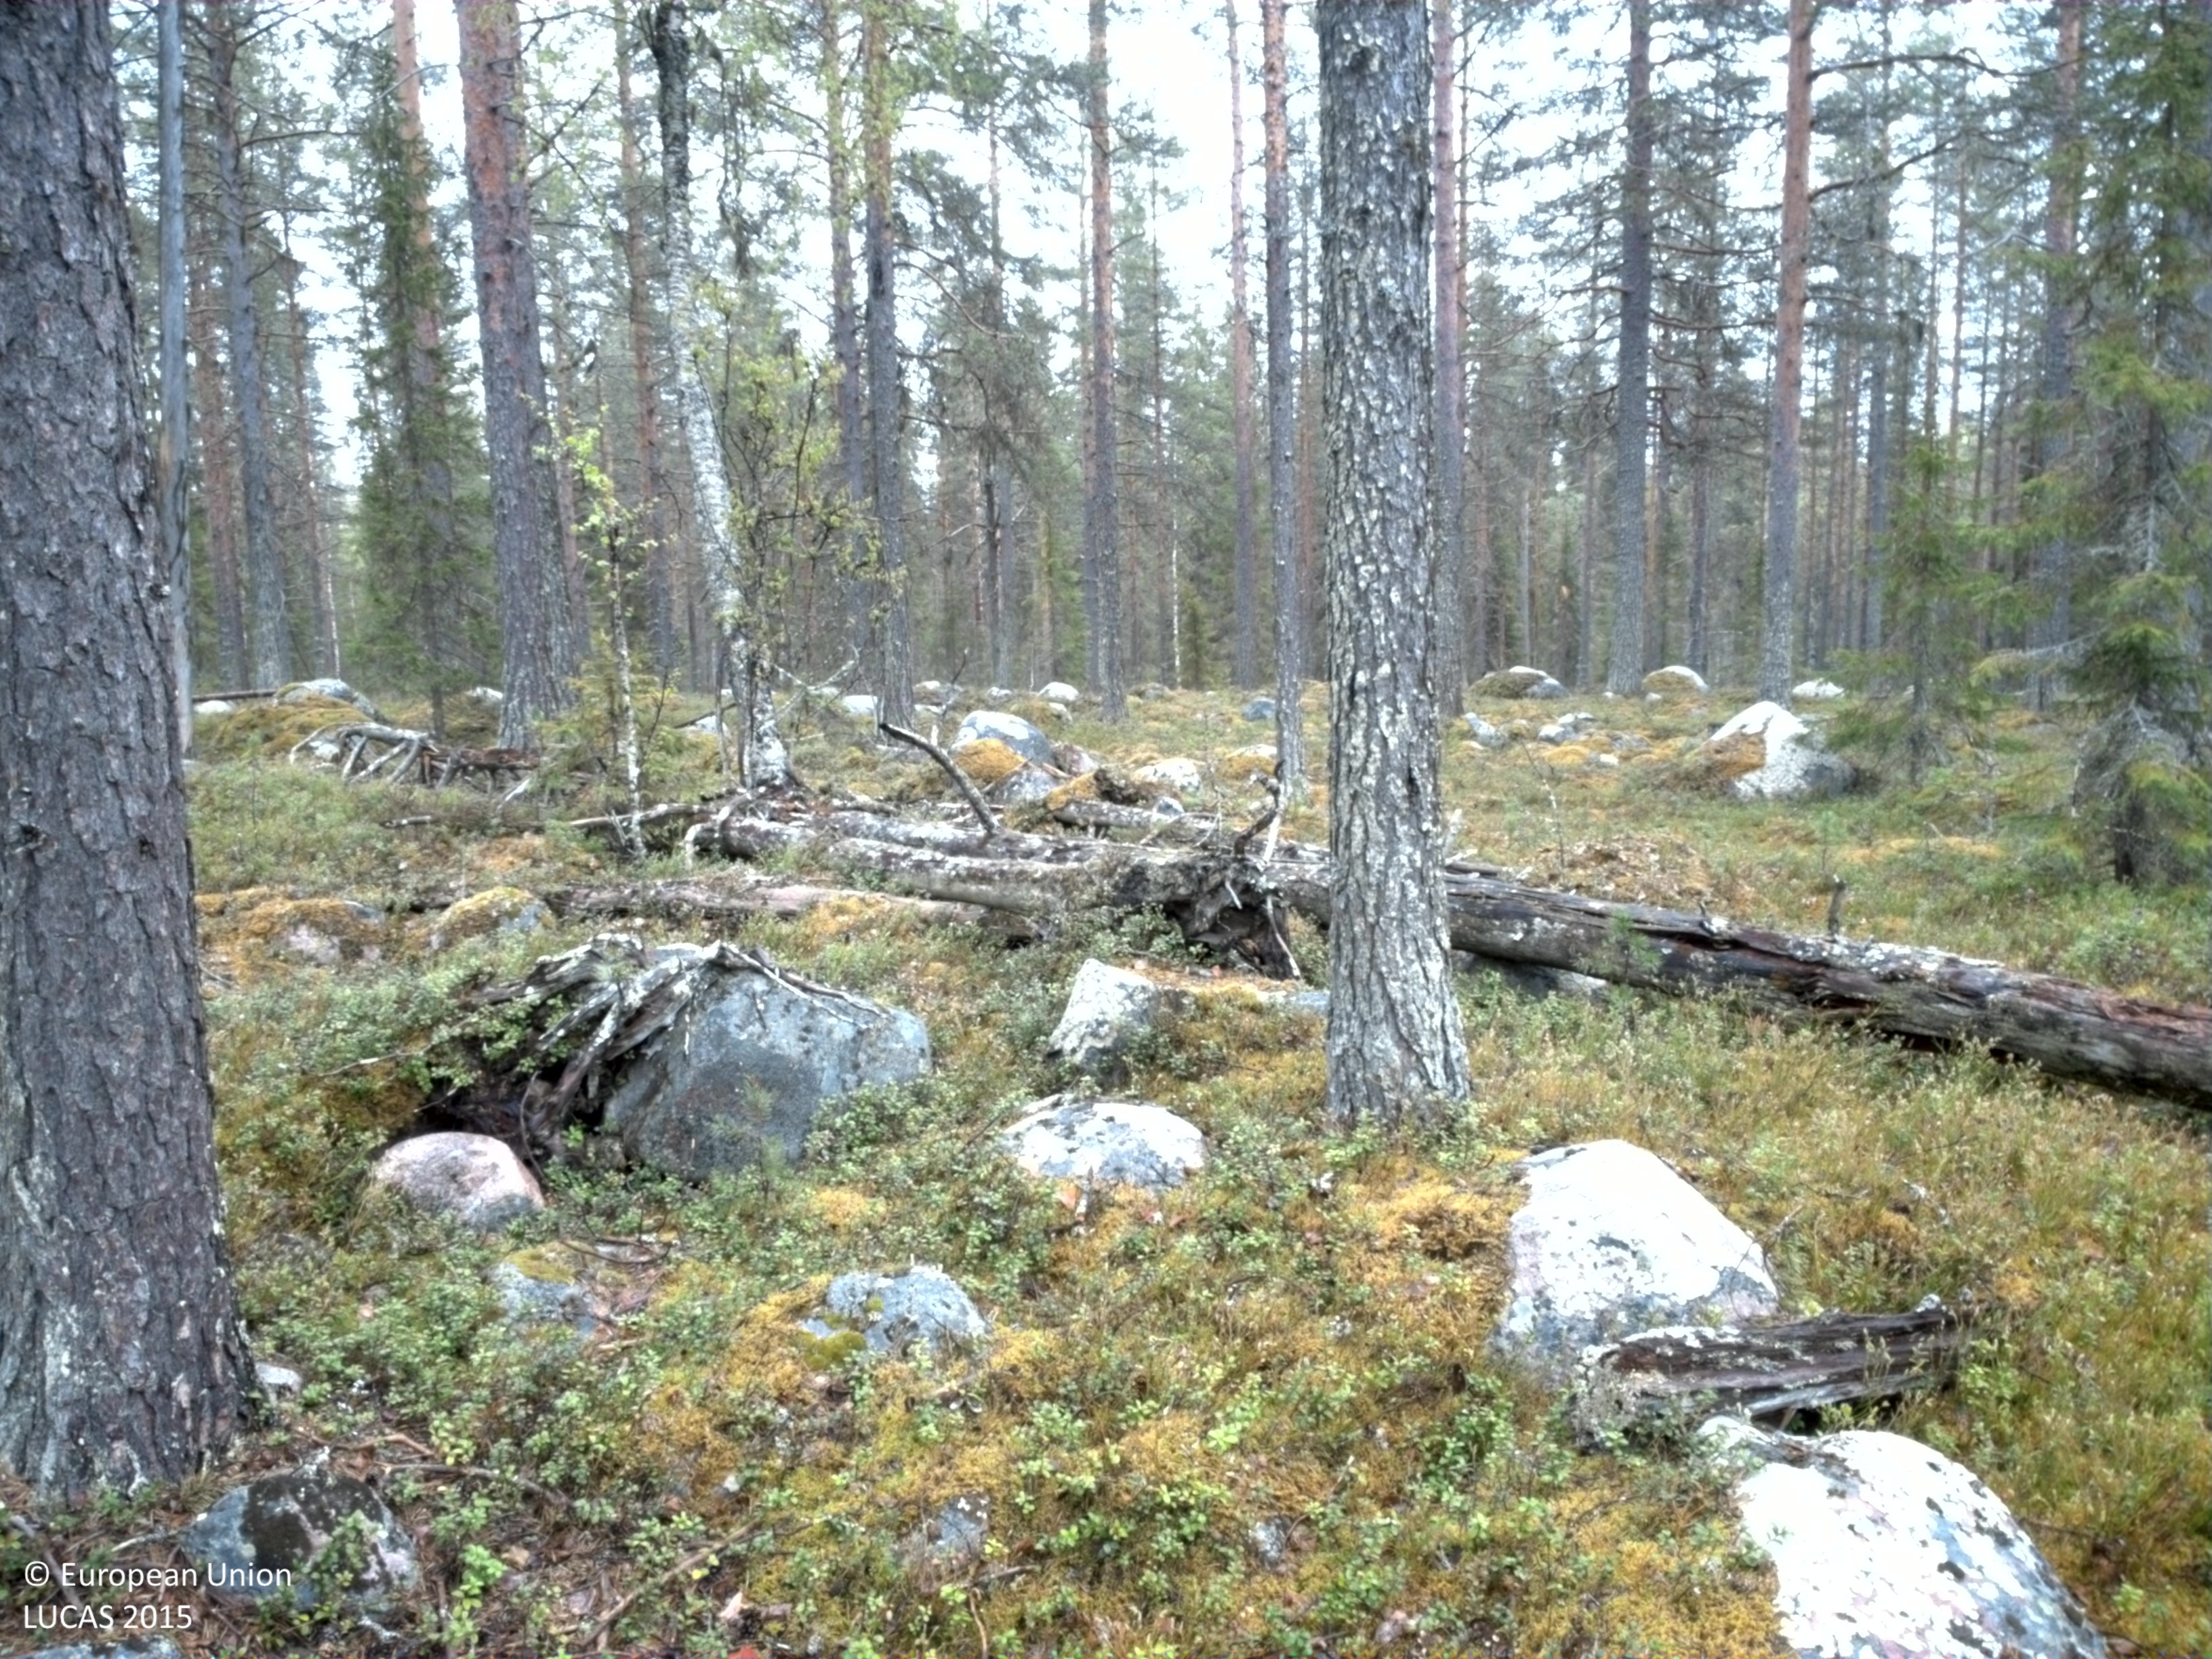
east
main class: Woodland
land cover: Pine dominated coniferous woodland
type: boreal forest
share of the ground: 50 - 75 %
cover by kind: coniferous forest trees 50 %, shrubs 25 %, consolidated bare surface 20 %, lichens and mosses 5 %
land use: Forestry
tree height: > 5 m
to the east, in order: Pine dominated coniferous woodland; Spruce dominated coniferous woodland; Spruce dominated mixed woodland
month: May
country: SE
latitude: 66.0837
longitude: 23.0034
